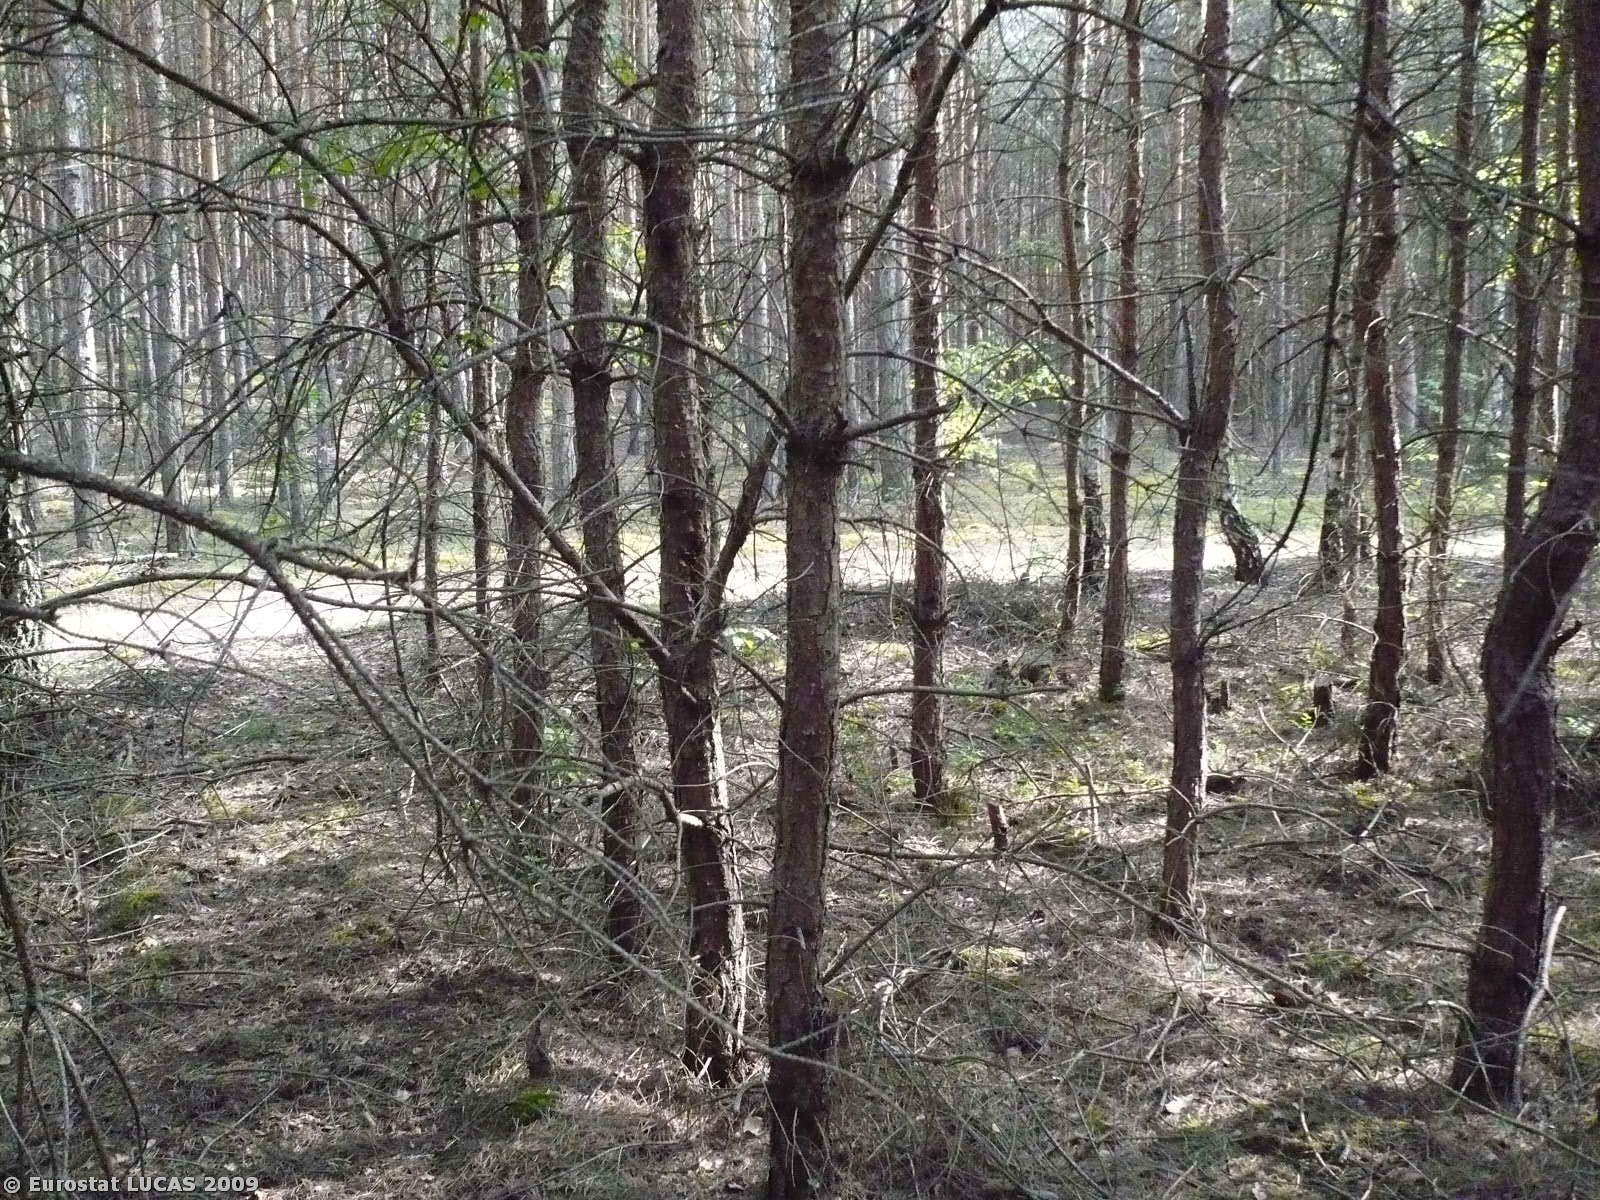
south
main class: Woodland
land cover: Coniferous woodland
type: hemiboreal forest and nemoral coniferous forest and mixed broadleaved-coniferous forest
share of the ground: > 75 %
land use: Forestry
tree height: > 5 m
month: May
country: PL
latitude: 52.0854
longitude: 15.1547
